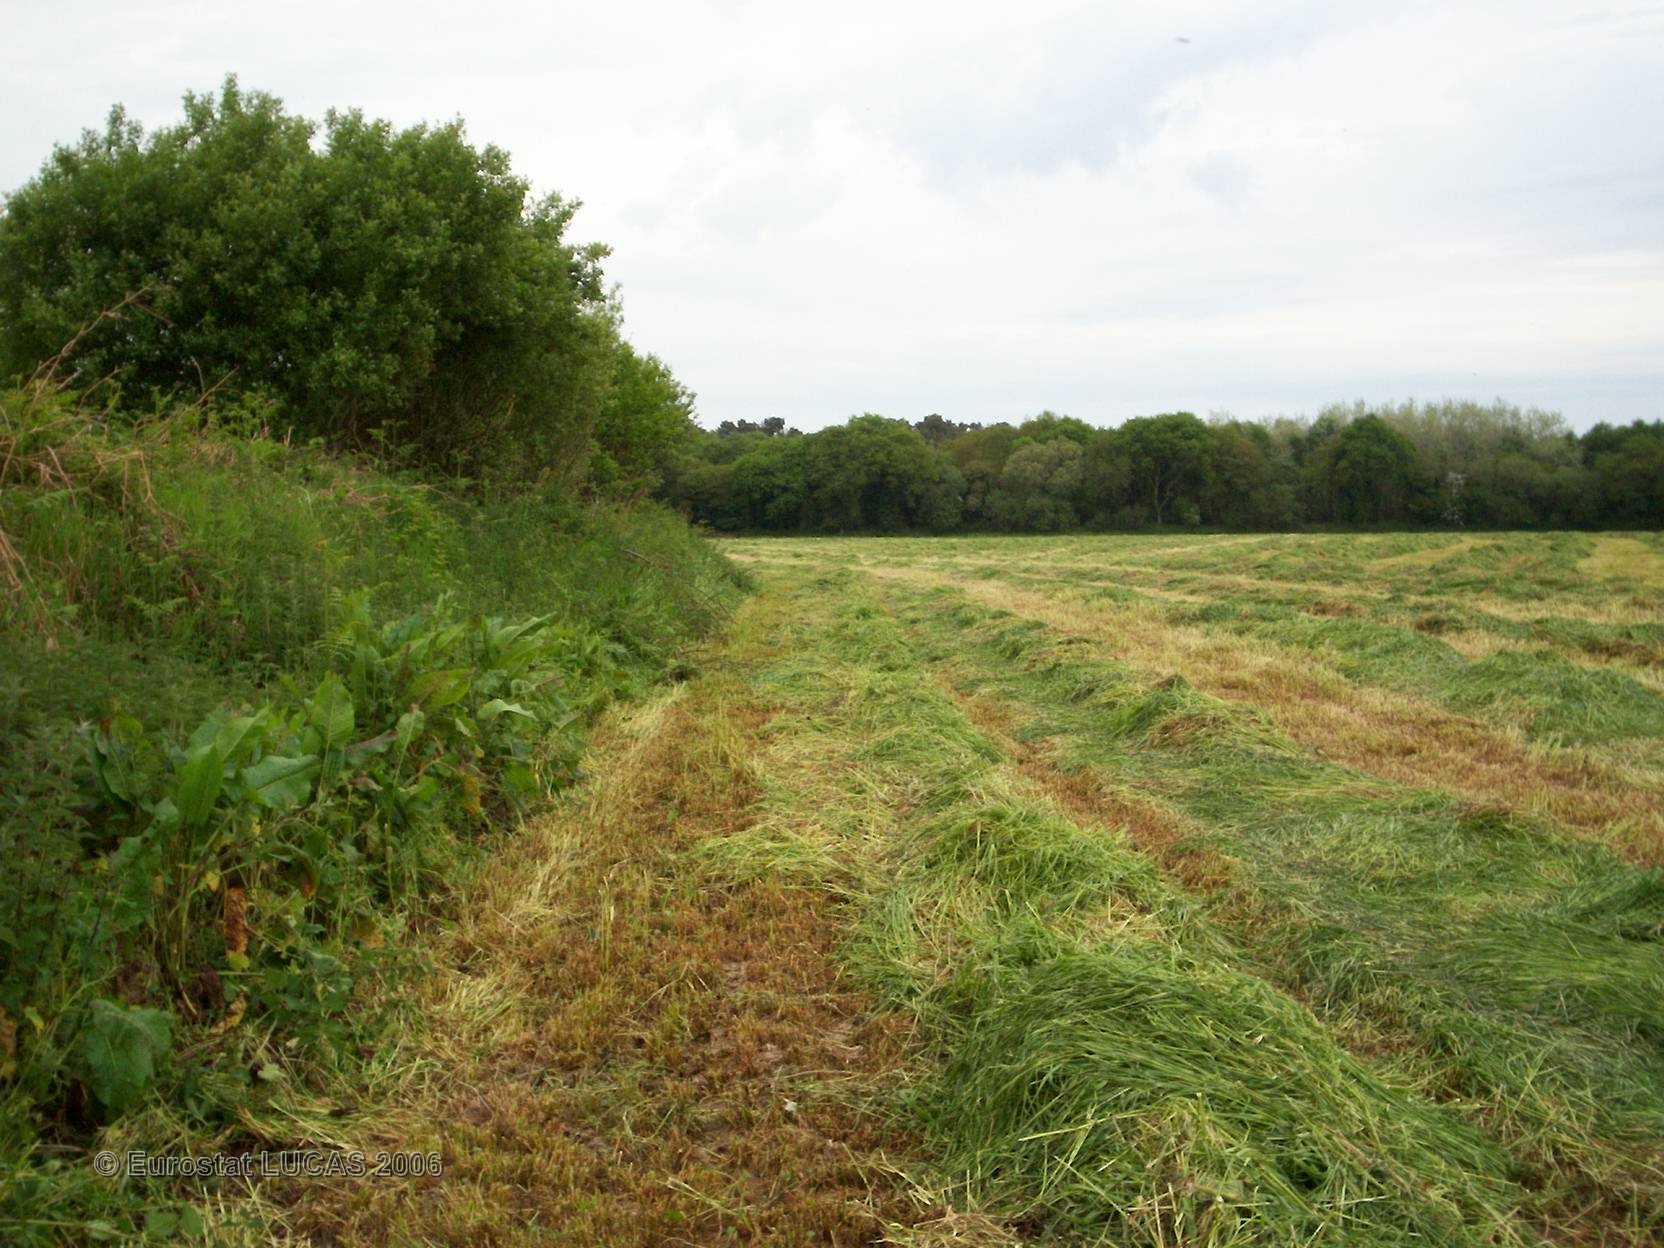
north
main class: Grassland
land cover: Grassland without tree/shrub cover
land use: Agriculture (excluding fallow land and kitchen gardens)
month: May
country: FR
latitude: 48.7514
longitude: -3.0887
